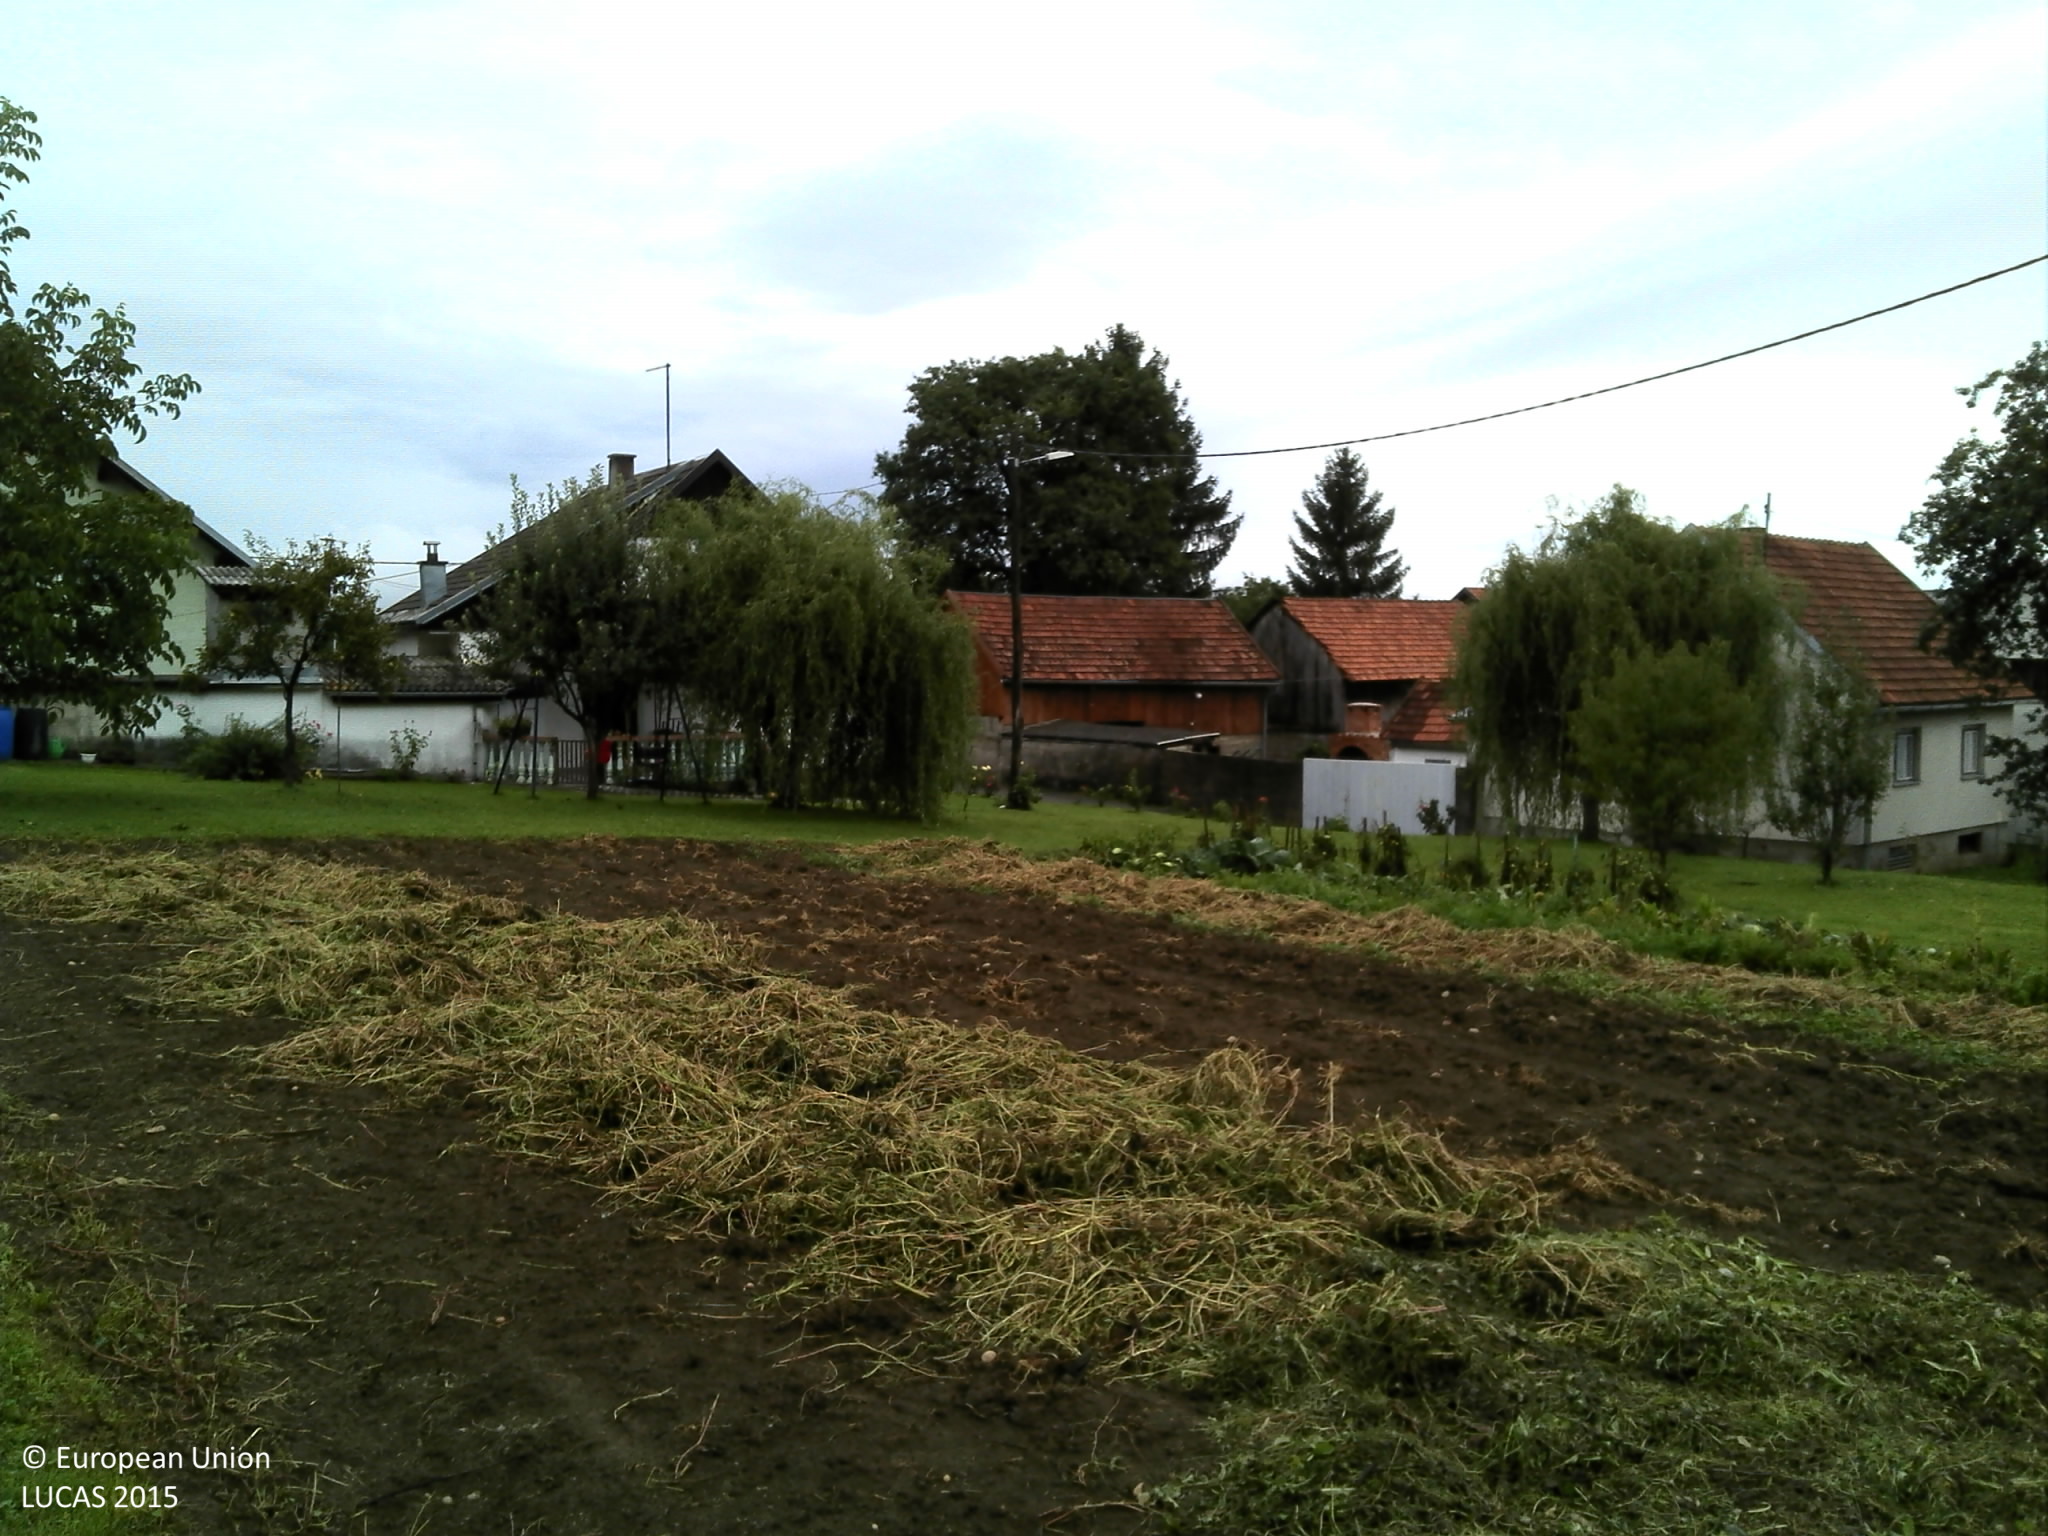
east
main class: Grassland
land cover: Grassland without tree/shrub cover
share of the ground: > 75 %
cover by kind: herbaceous plants 100 %
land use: Residential
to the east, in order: Grassland without tree/shrub cover; Other fresh vegetables; Artificial constructions in urban areas; Other fruit trees and berries; Fences; Other fruit trees and berries; Fences; Other bare soil; Electric lines; Grassland without tree/shrub cover
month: September
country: HR
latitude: 45.2483
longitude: 15.2318
